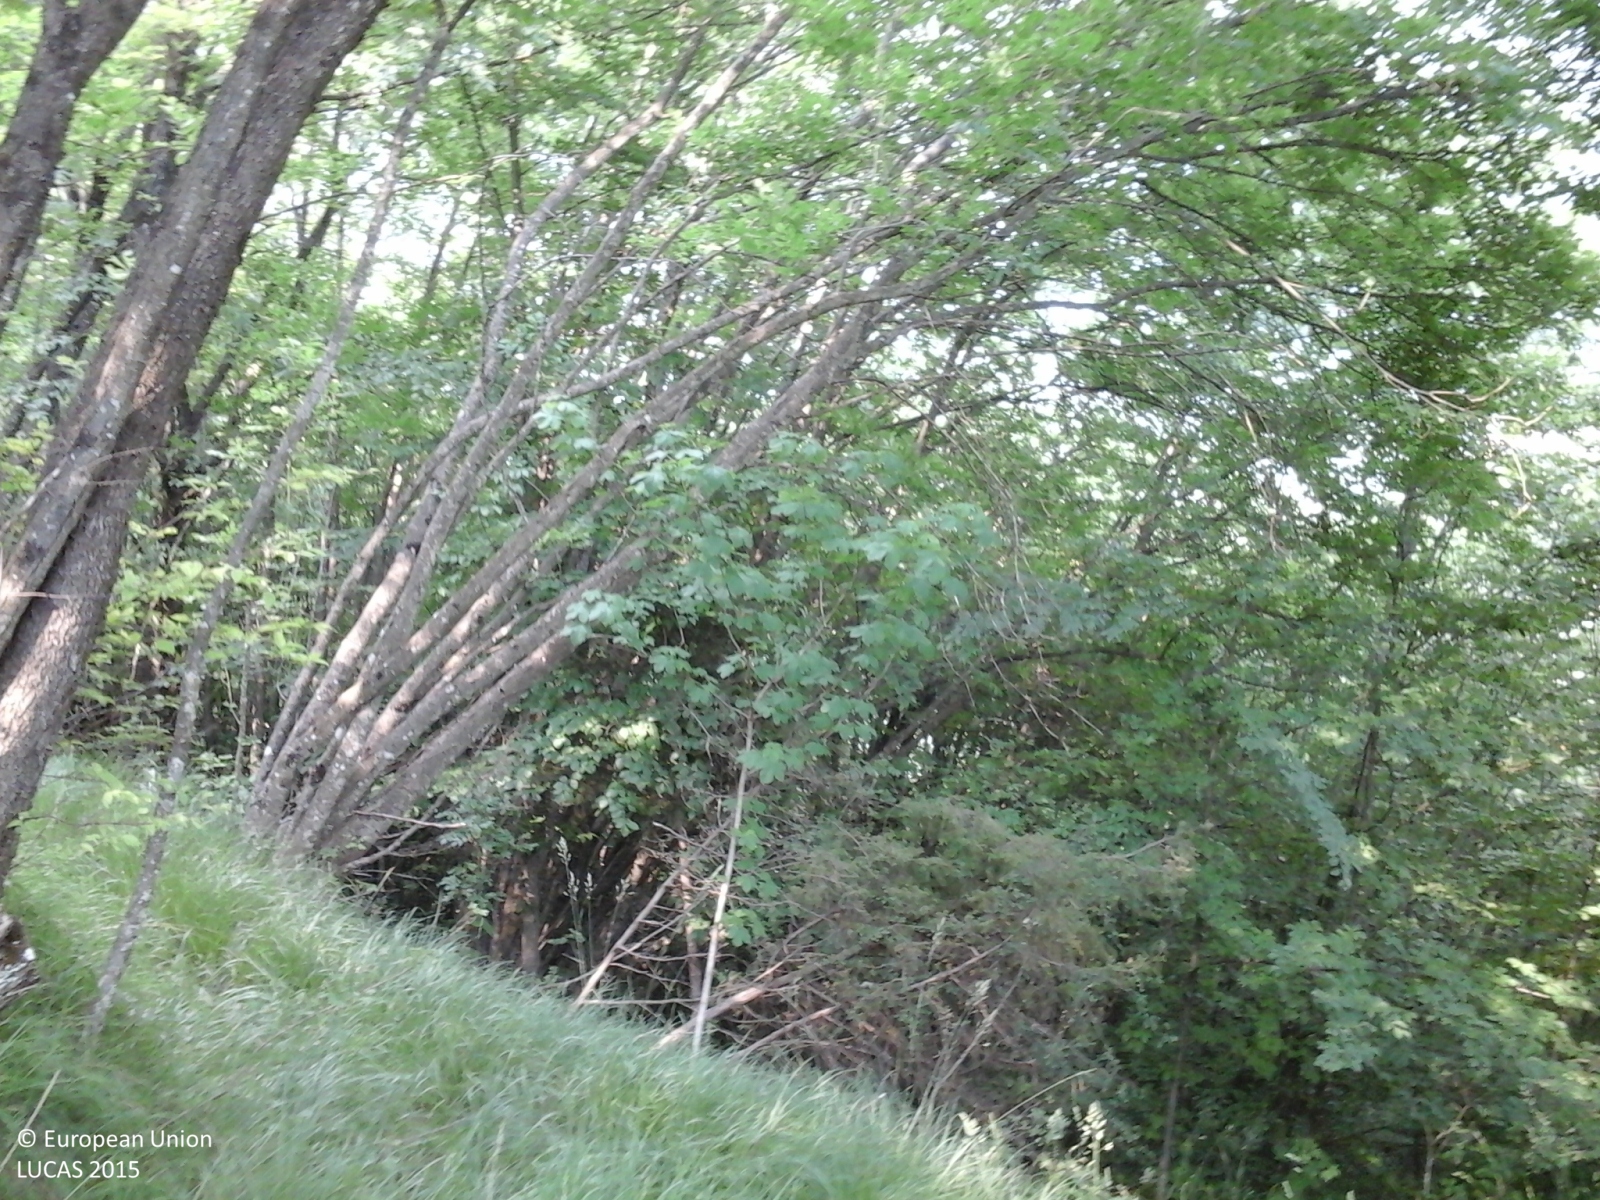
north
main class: Woodland
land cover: Broadleaved woodland
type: thermophilous deciduous forest
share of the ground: > 75 %
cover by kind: broadleaved forest trees 100 %
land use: Semi-natural and natural areas not in use
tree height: > 5 m
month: June
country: IT
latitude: 46.1808
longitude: 12.3678
